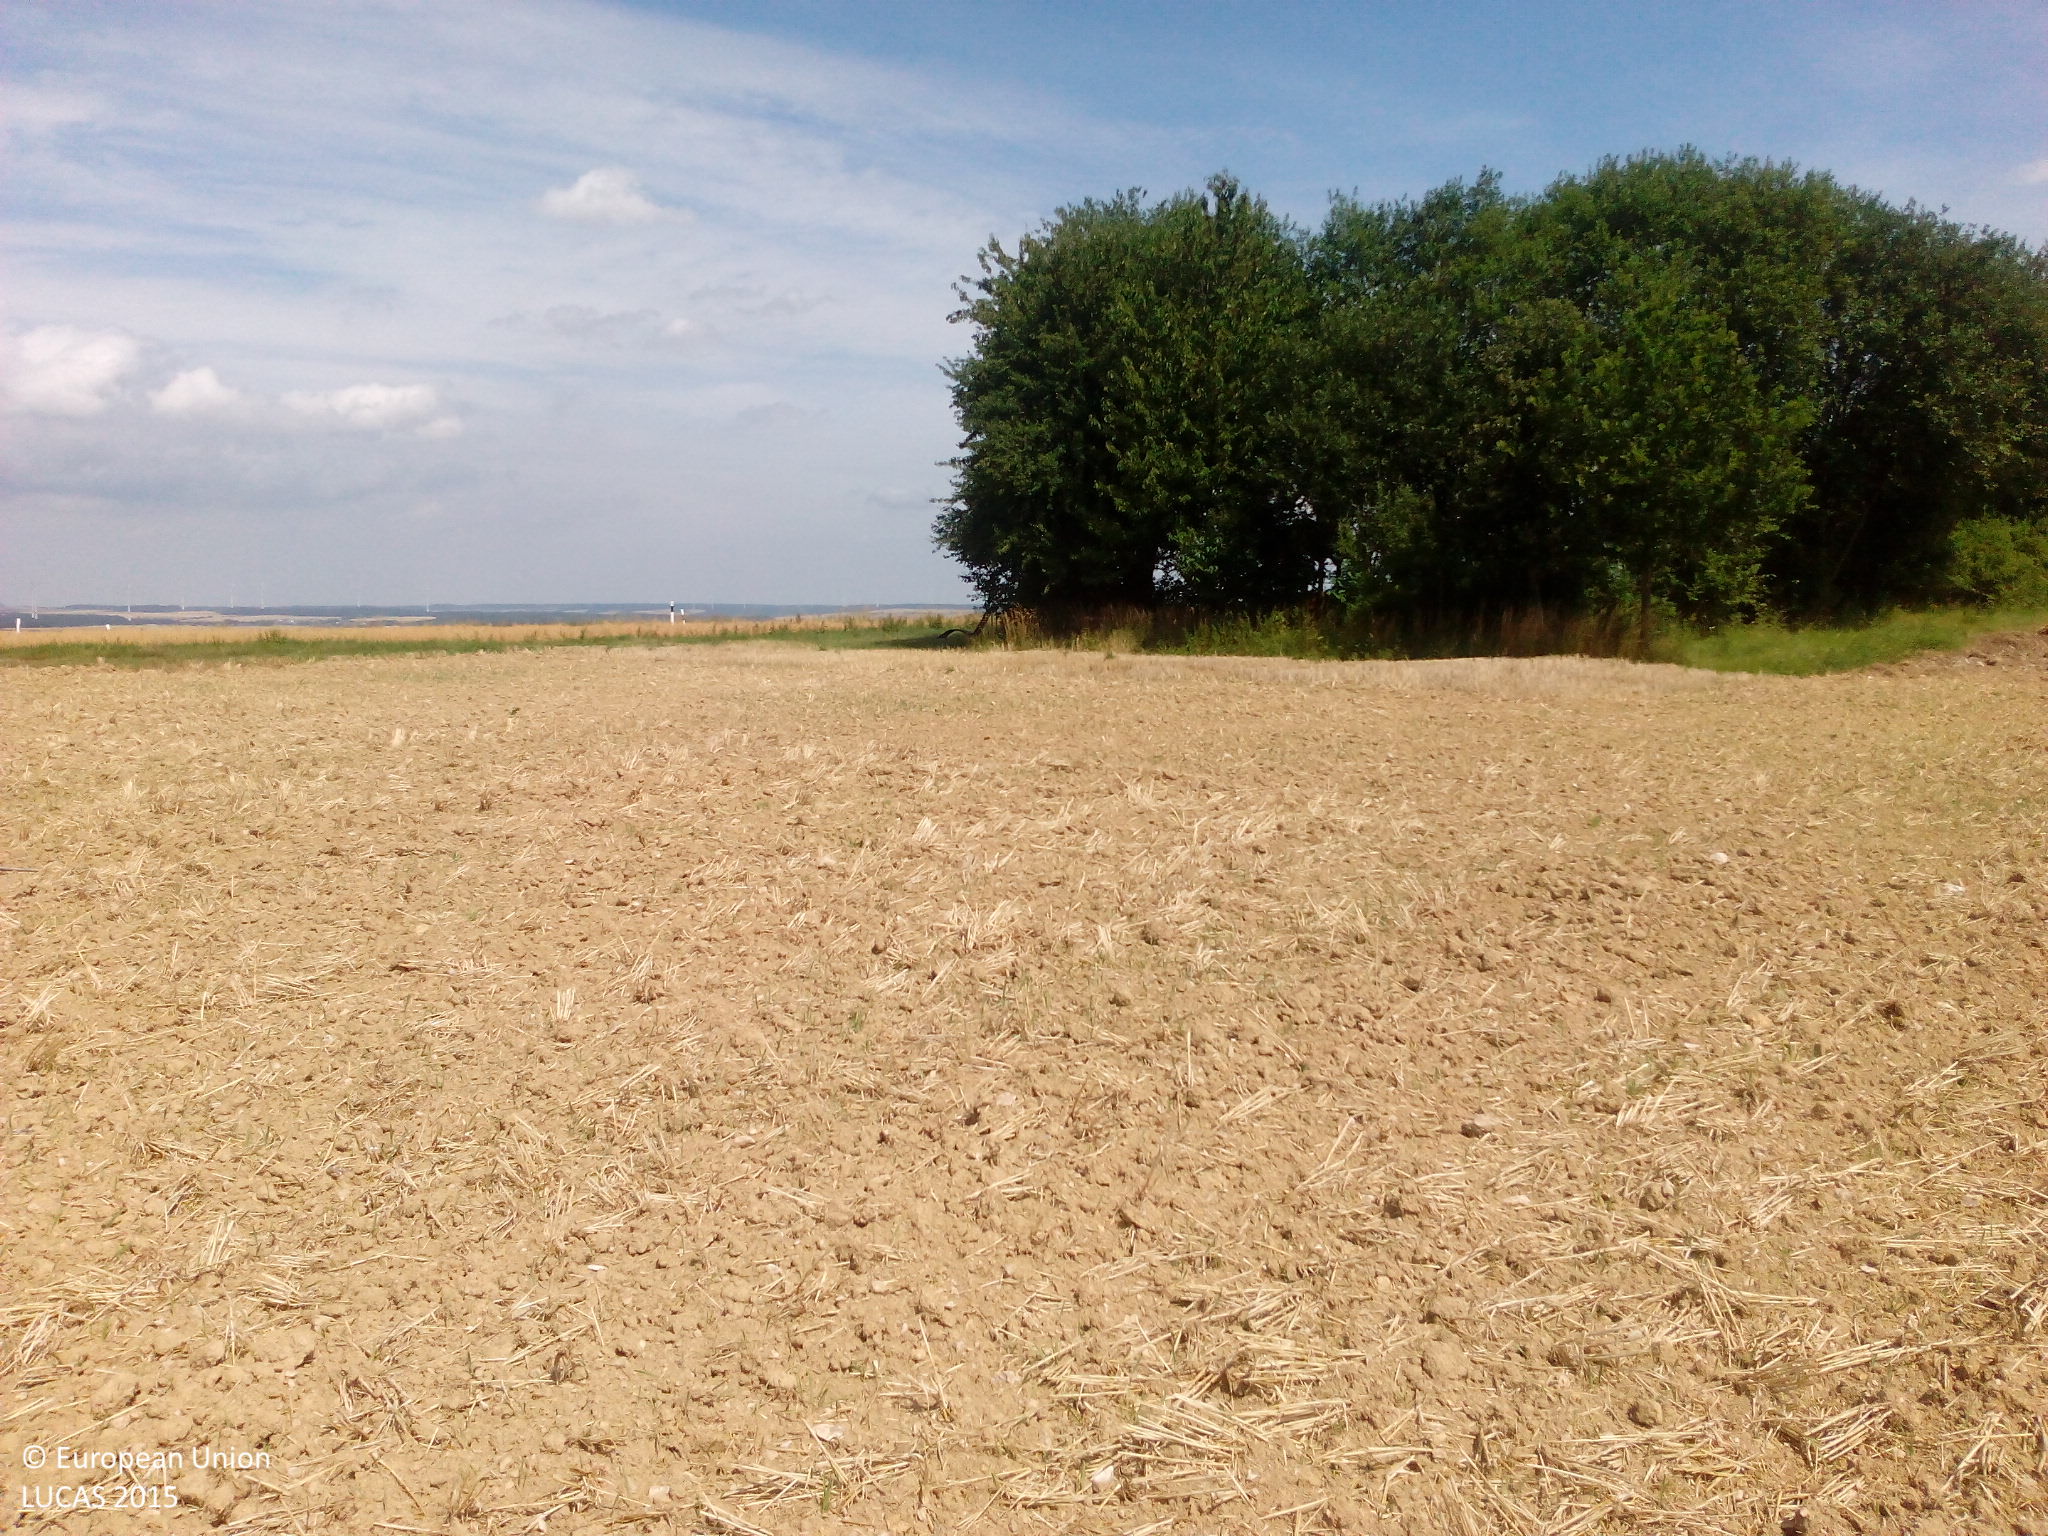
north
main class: Cropland
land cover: Barley
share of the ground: < 10 %
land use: Agriculture (excluding fallow land and kitchen gardens)
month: July
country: DE
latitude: 49.9231
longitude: 7.5071
